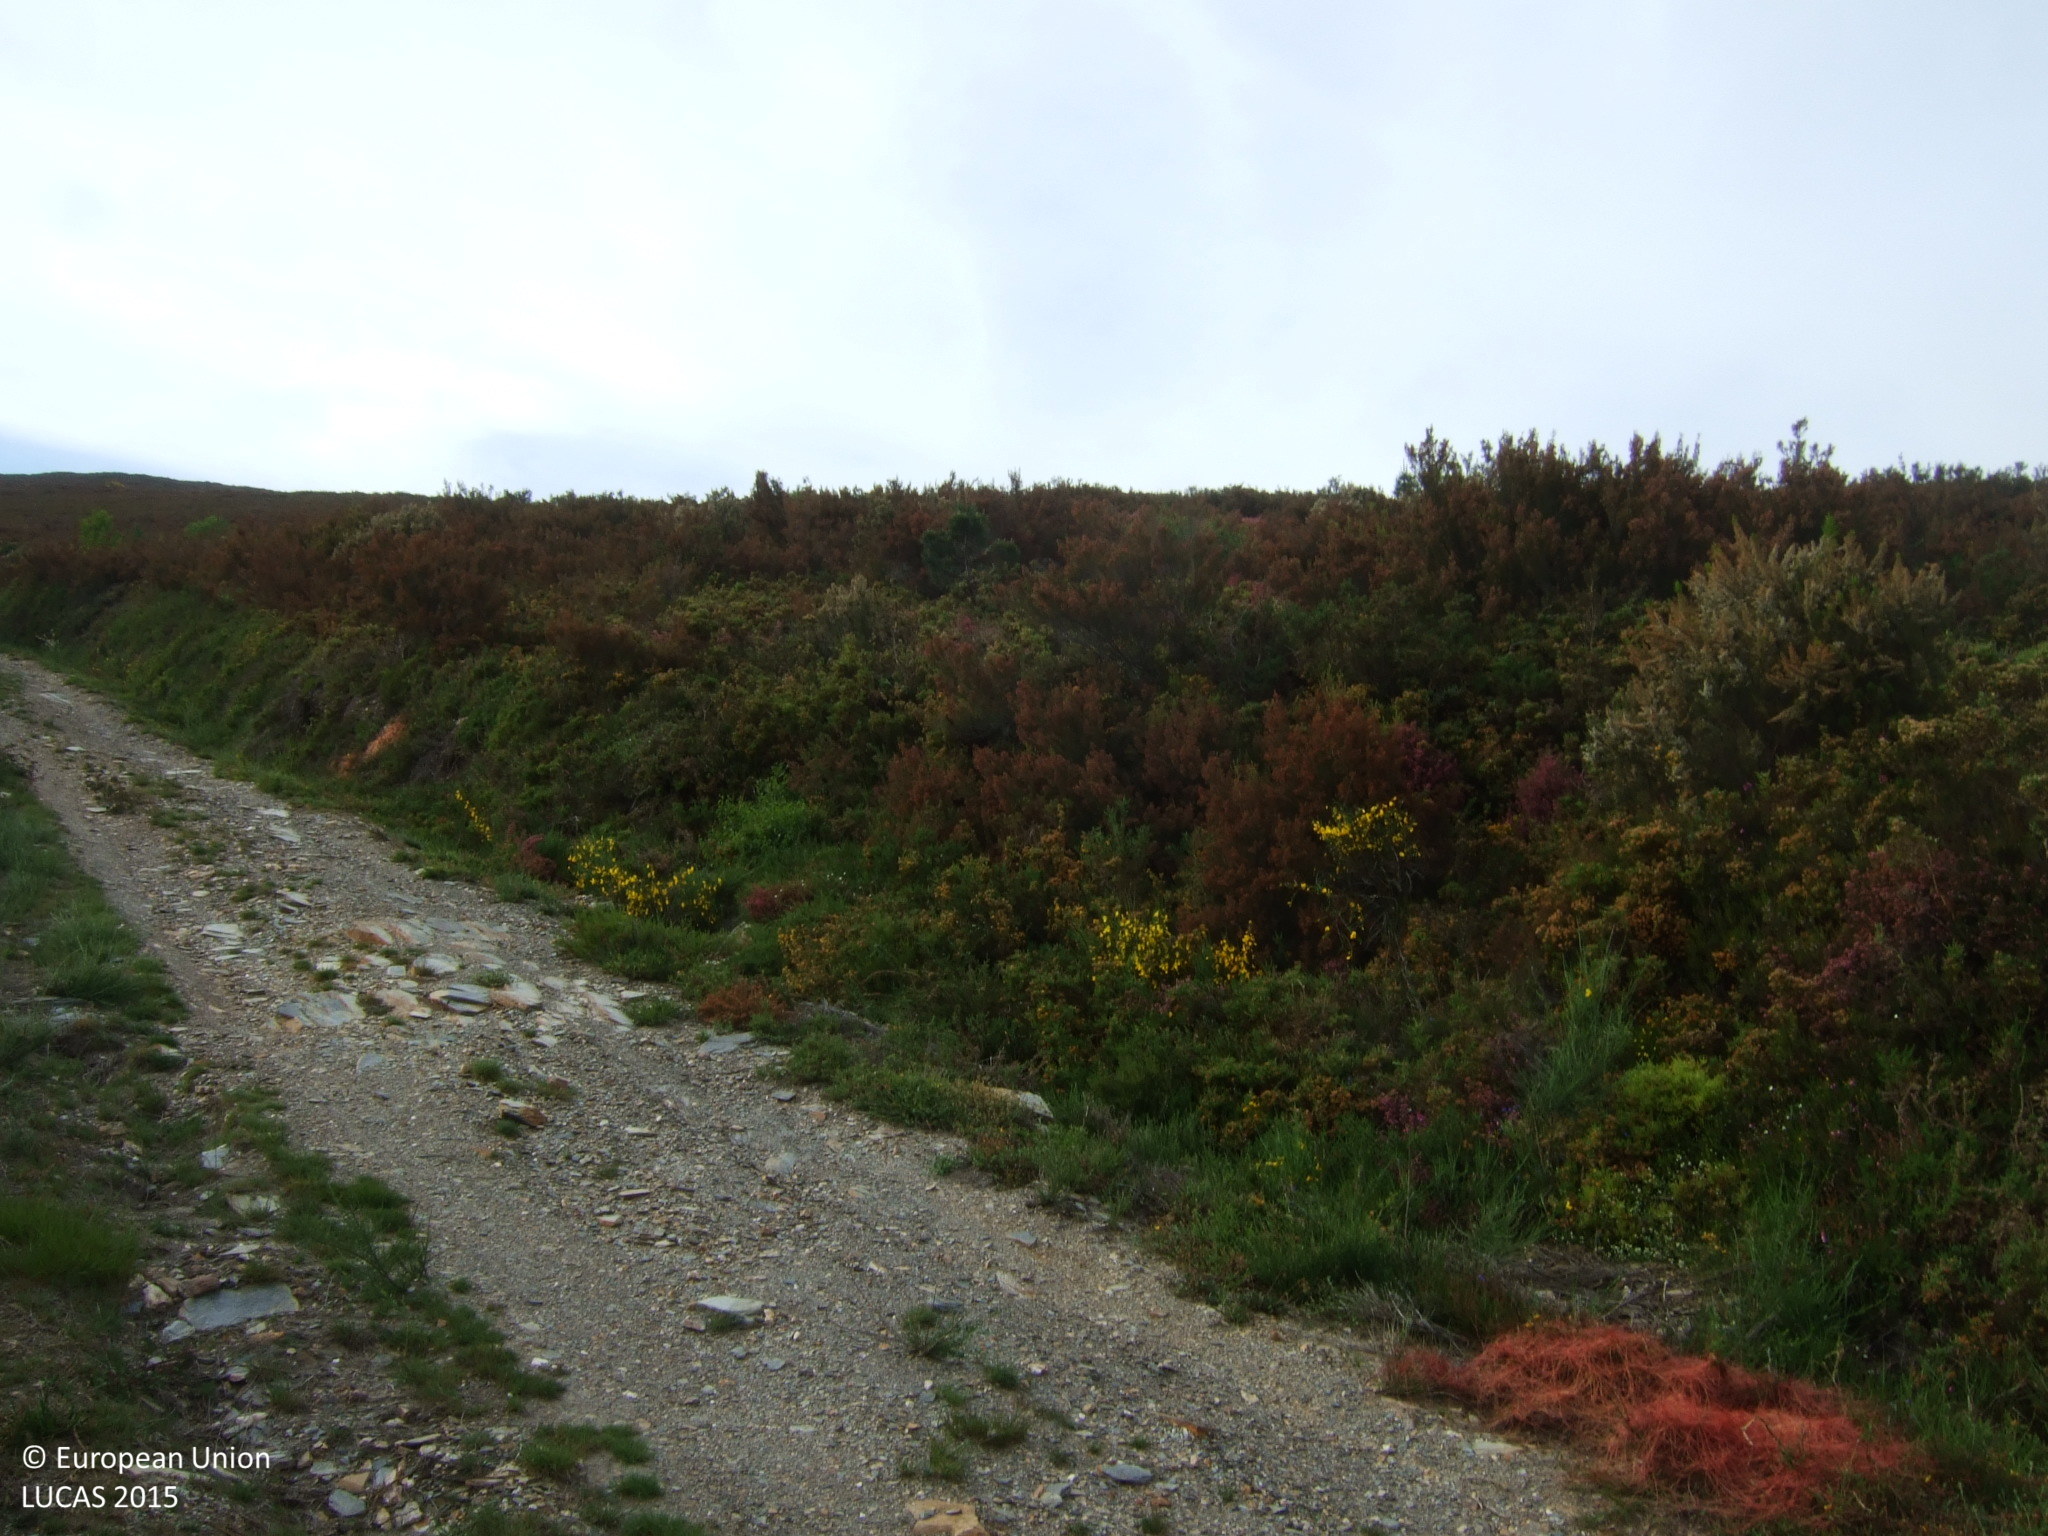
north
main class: Shrubland
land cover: Shrubland without tree cover
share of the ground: > 75 %
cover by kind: shrubs 100 %
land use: Semi-natural and natural areas not in use
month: June
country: ES
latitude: 42.7796
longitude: -7.2643
